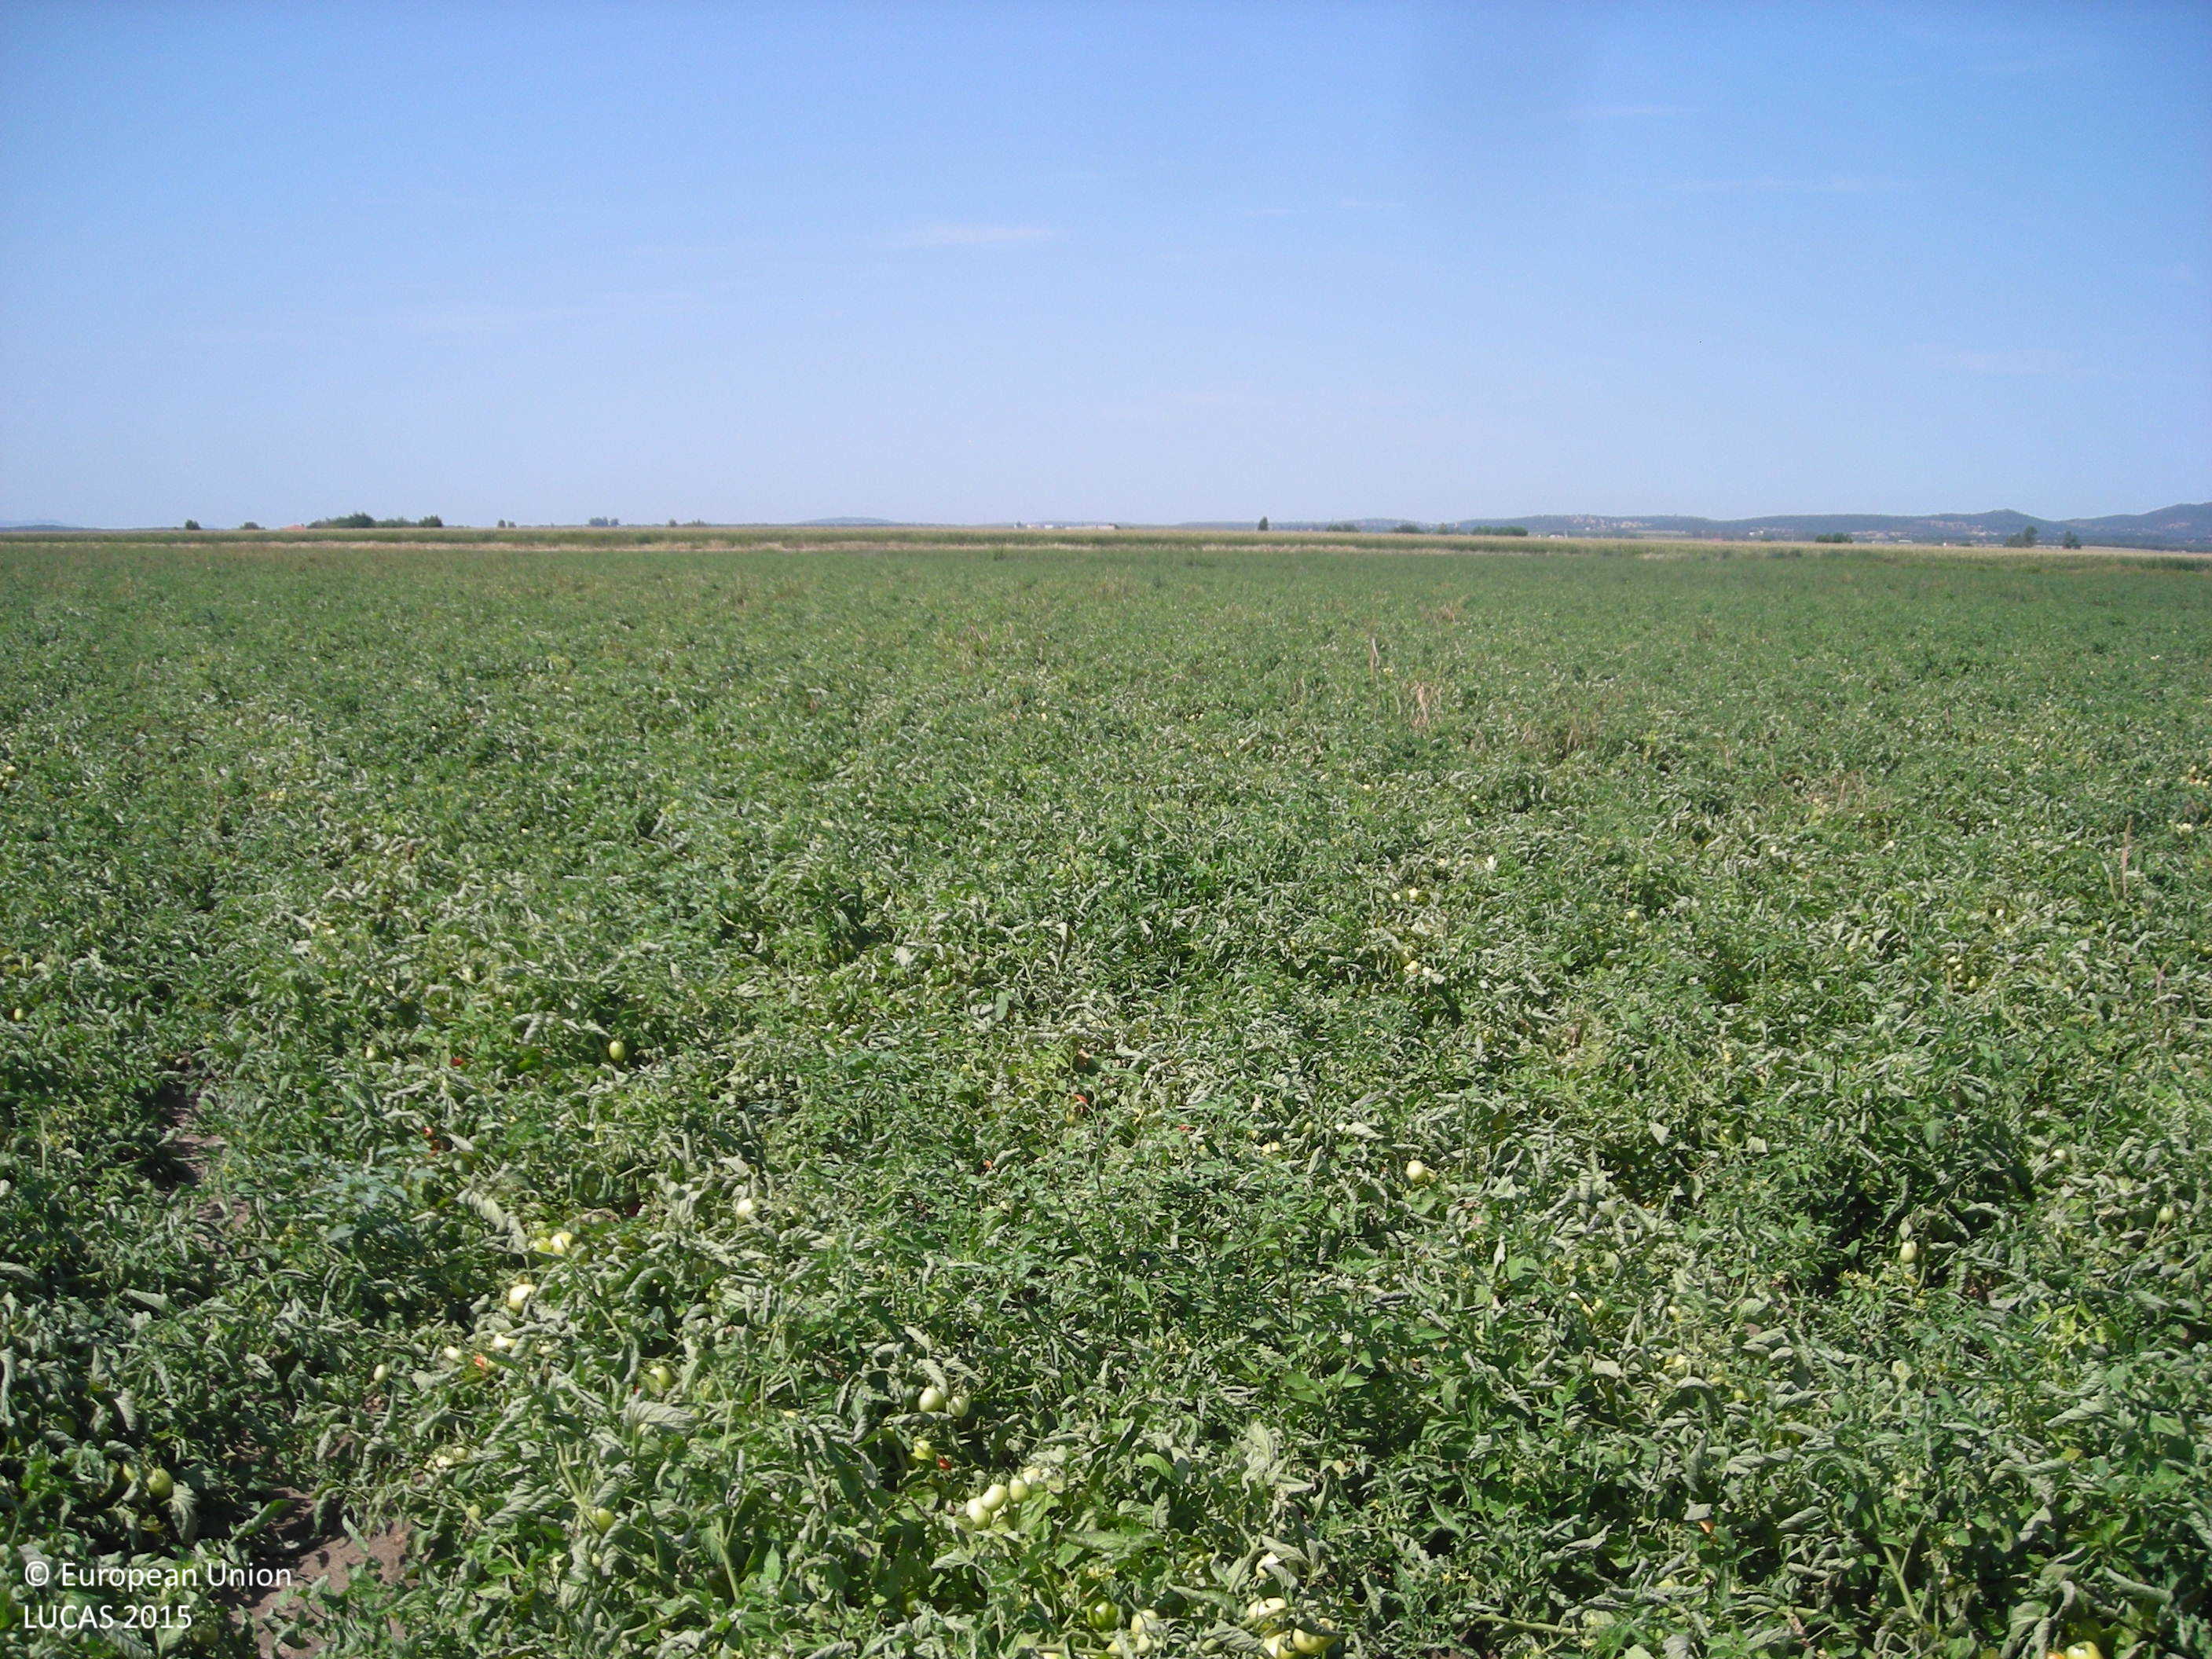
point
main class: Cropland
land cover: Tomatoes
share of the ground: > 75 %
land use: Agriculture (excluding fallow land and kitchen gardens)
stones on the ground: < 10 %
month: July
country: ES
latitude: 39.0923
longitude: -5.9978
